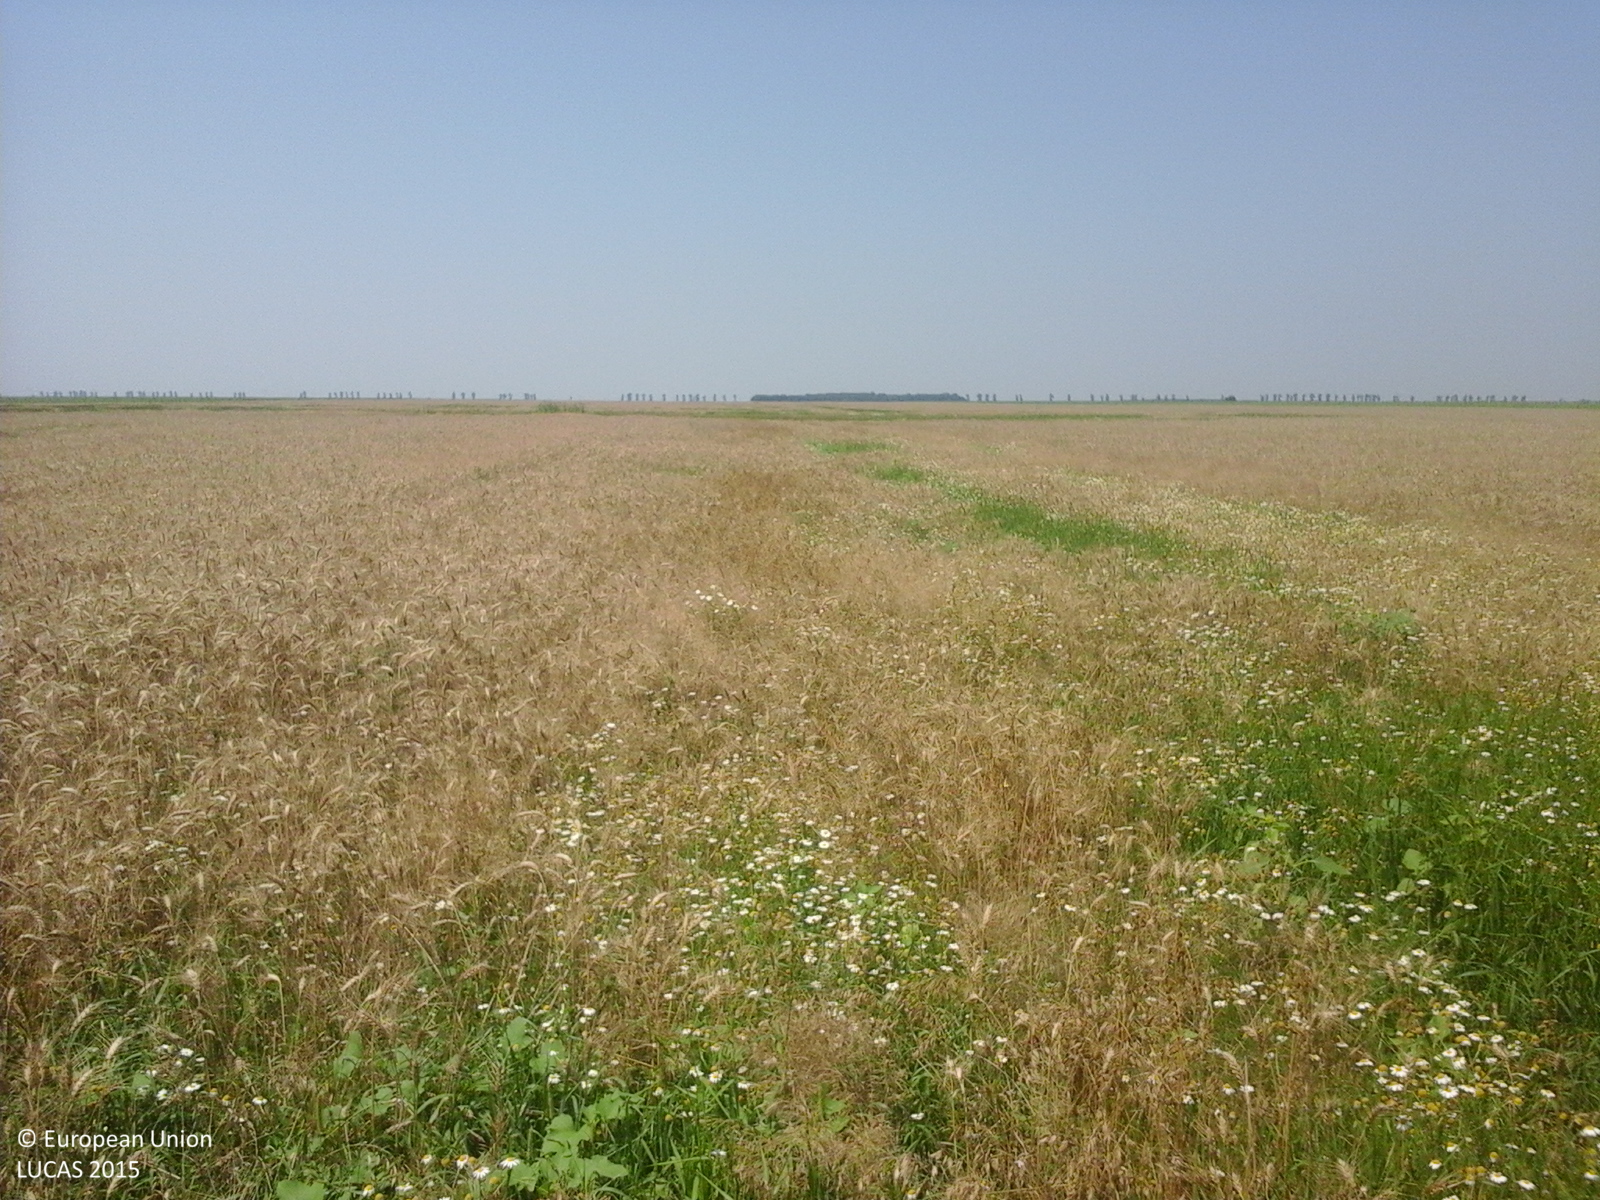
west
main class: Cropland
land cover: Common wheat
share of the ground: > 75 %
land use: Agriculture (excluding fallow land and kitchen gardens)
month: July
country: RO
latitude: 44.3210
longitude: 24.9620
